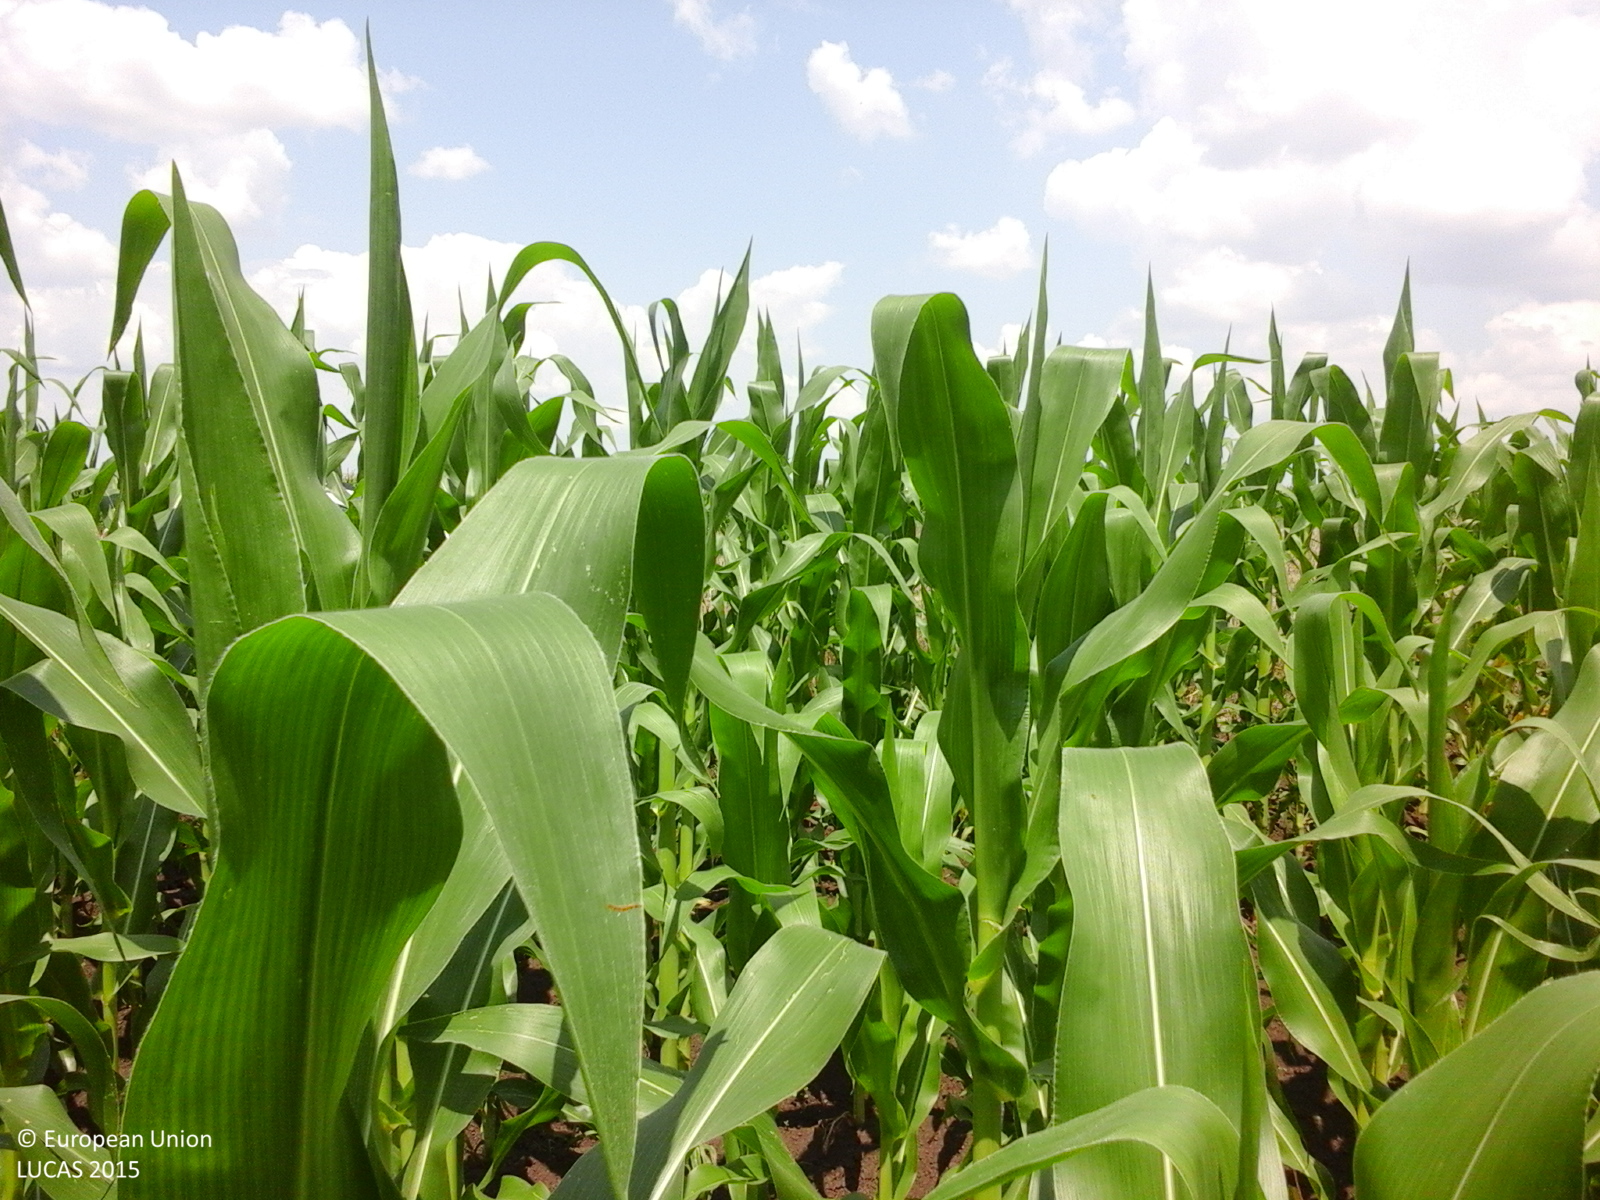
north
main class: Cropland
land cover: Maize
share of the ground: > 75 %
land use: Agriculture (excluding fallow land and kitchen gardens)
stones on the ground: < 10 %
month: July
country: RO
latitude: 43.9867
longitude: 25.4844
